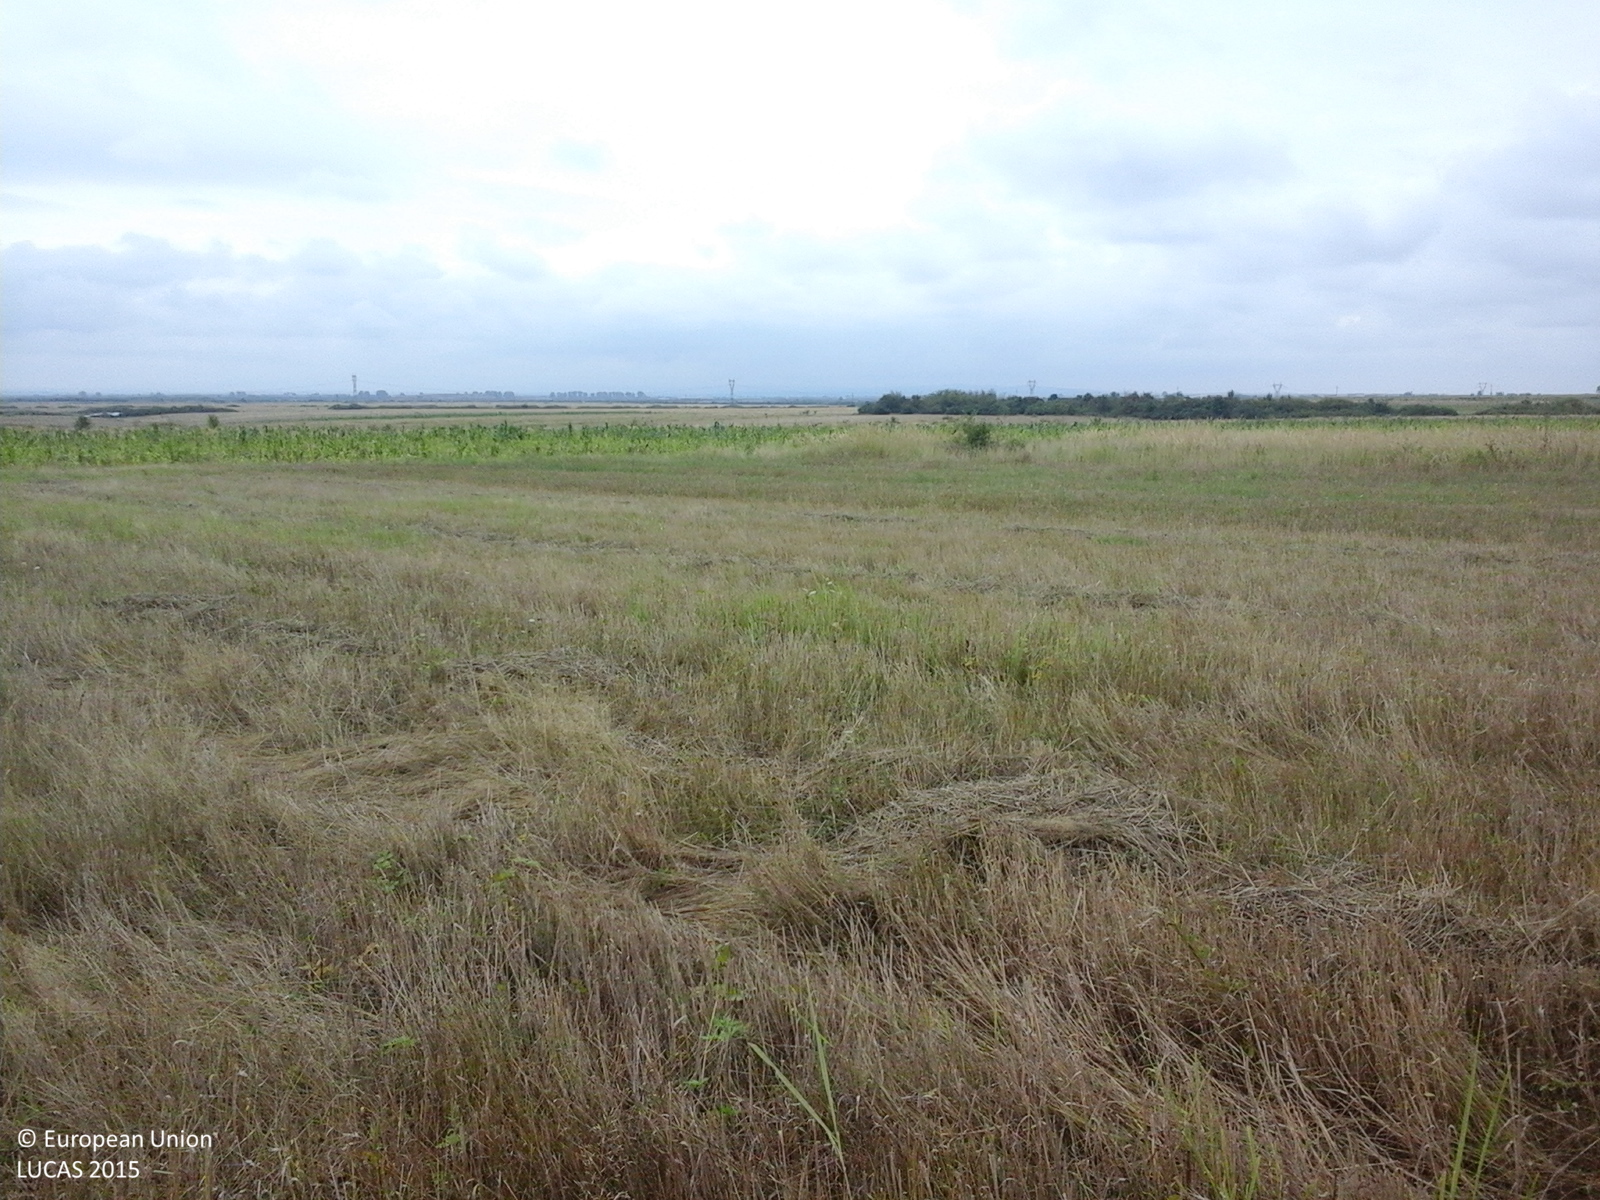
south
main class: Cropland
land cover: Common wheat
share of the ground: > 75 %
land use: Agriculture (excluding fallow land and kitchen gardens)
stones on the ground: < 10 %
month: August
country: RO
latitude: 45.8269
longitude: 21.7641
